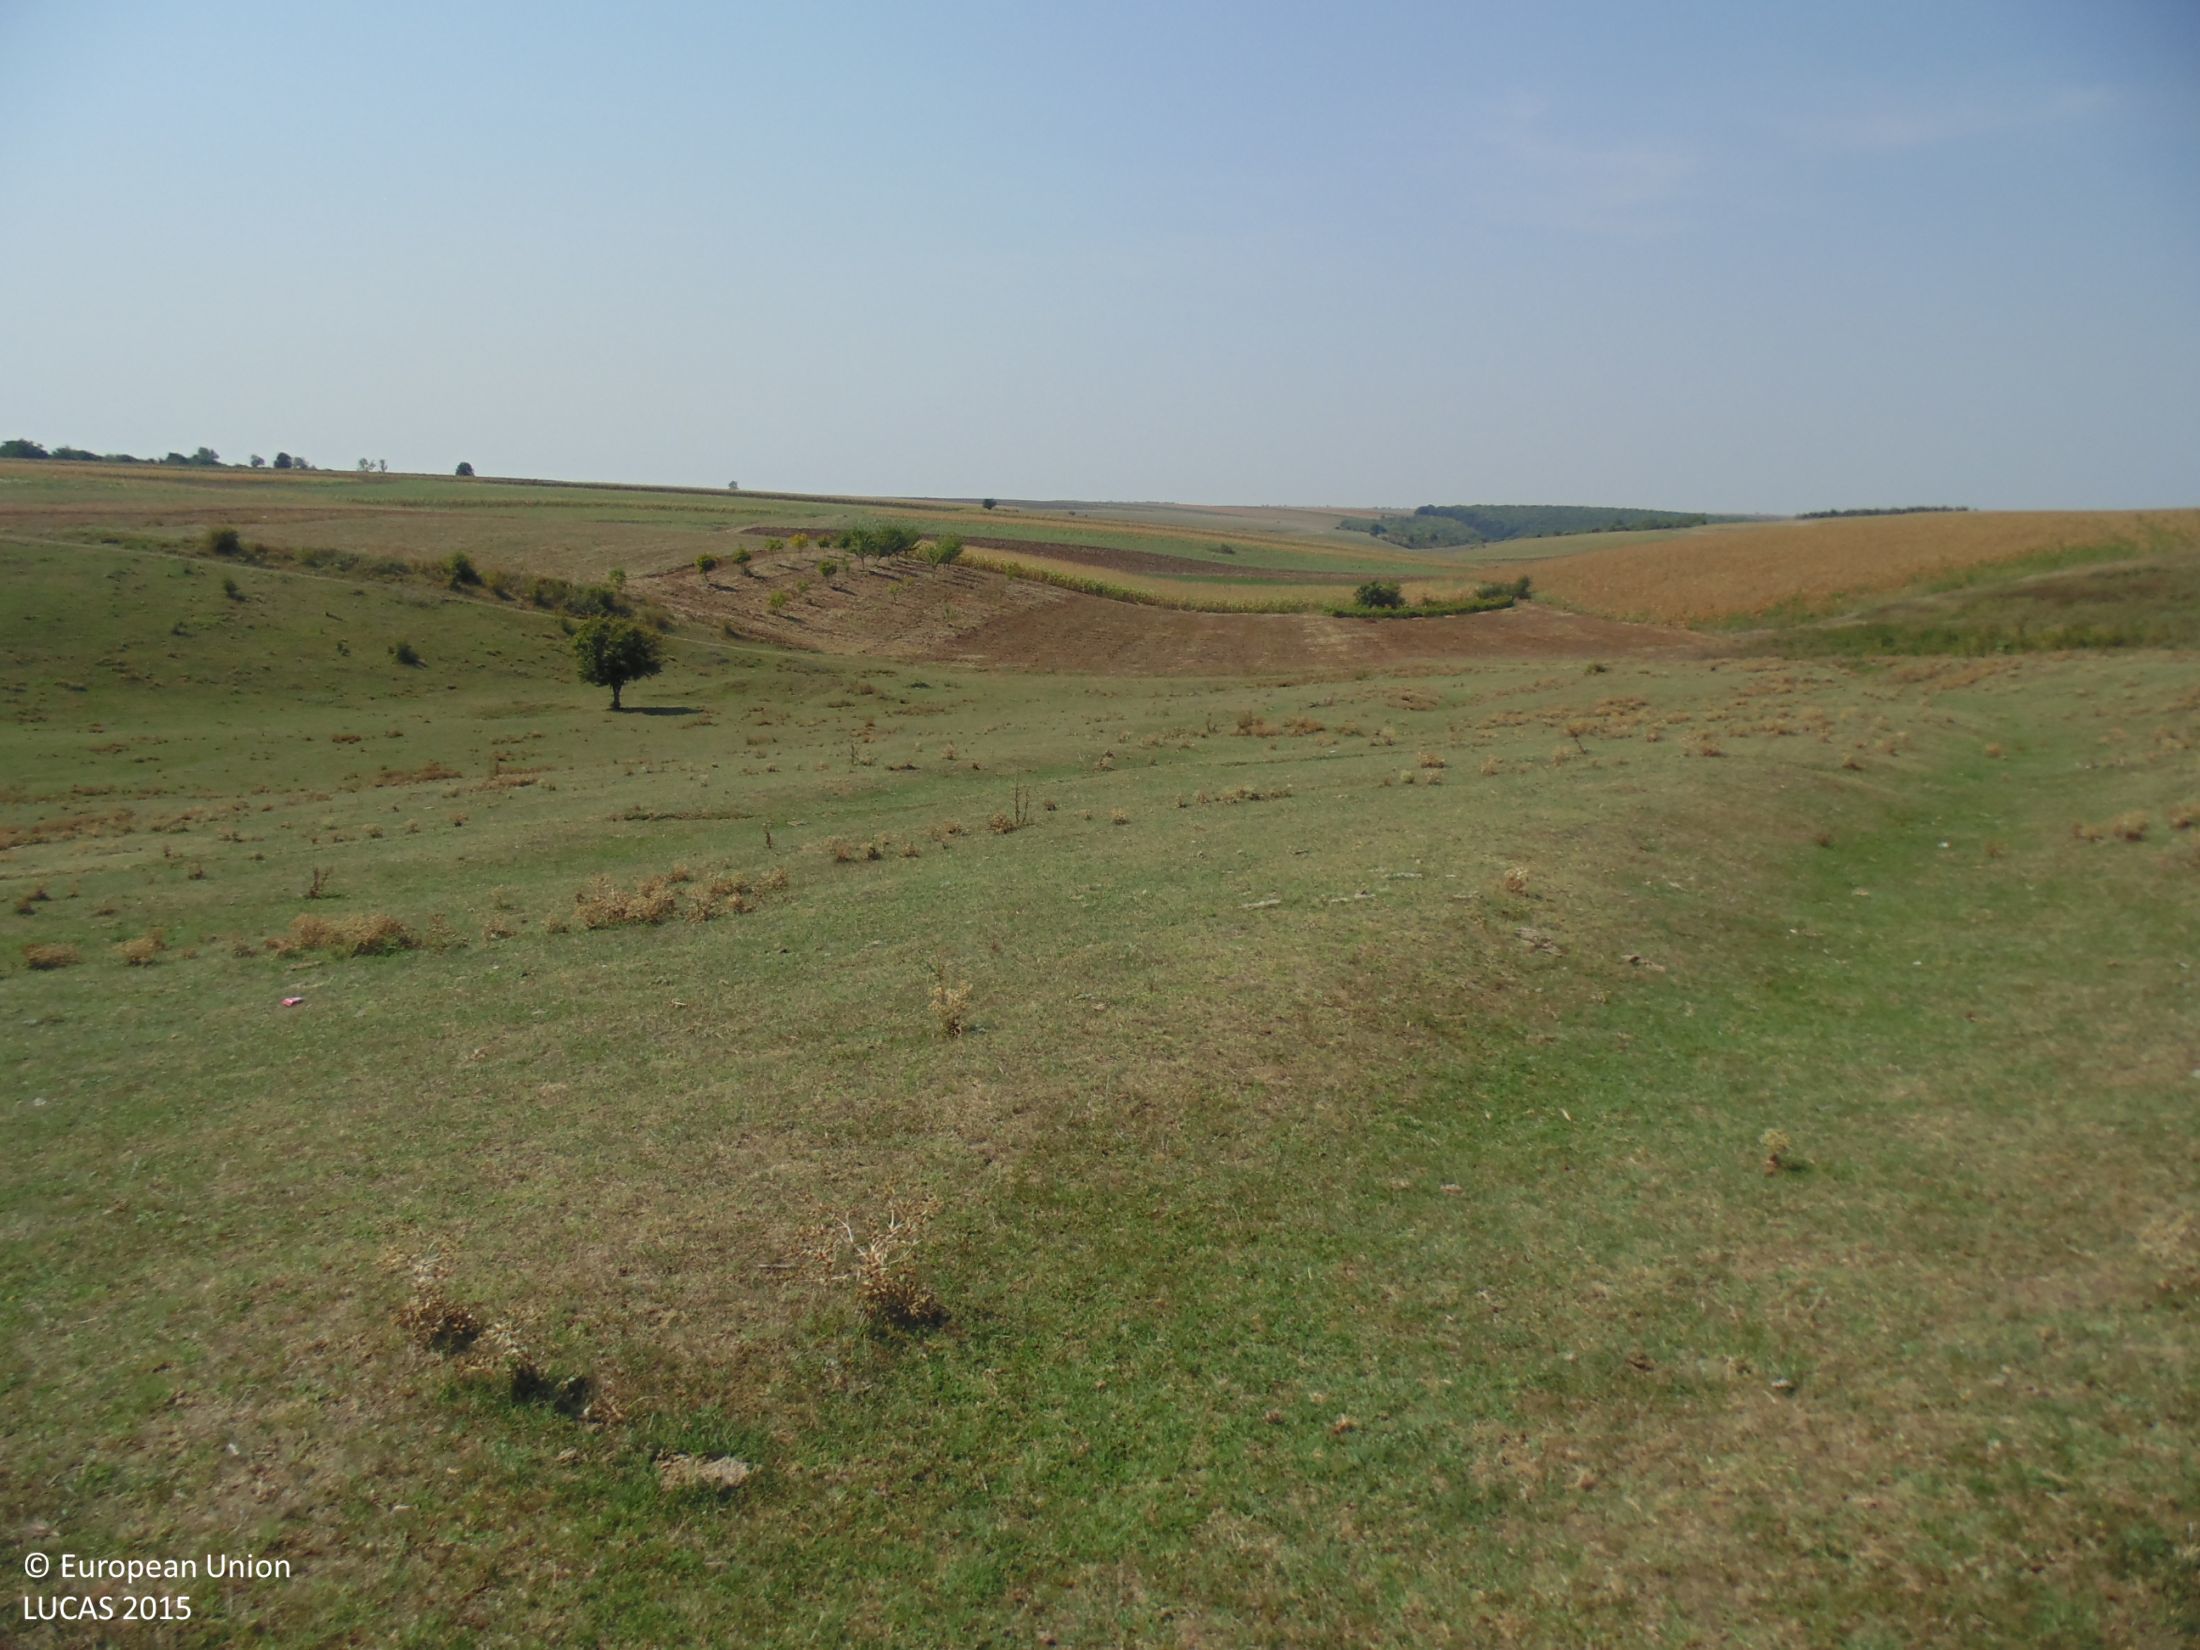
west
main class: Grassland
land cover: Grassland without tree/shrub cover
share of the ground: > 75 %
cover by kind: herbaceous plants 100 %
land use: Agriculture (excluding fallow land and kitchen gardens)
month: September
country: BG
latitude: 43.7928
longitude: 26.9338
